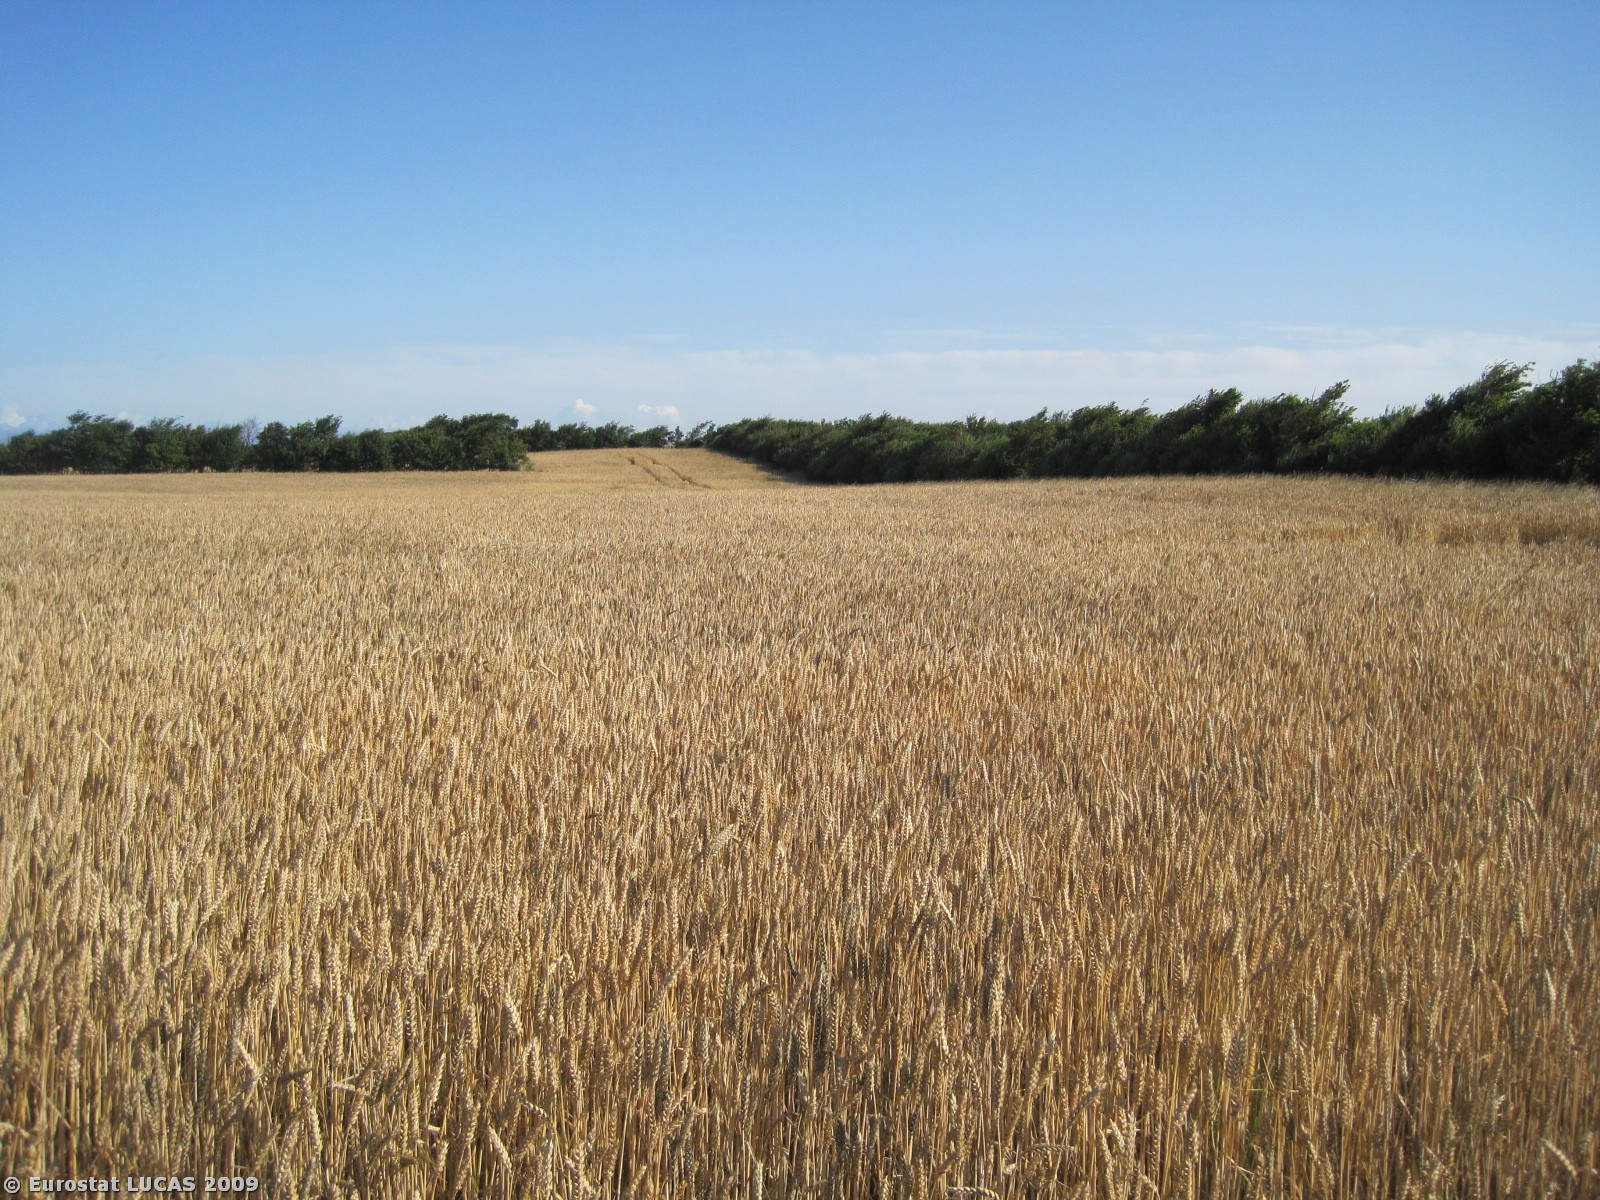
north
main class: Cropland
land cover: Common wheat
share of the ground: > 75 %
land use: Agriculture (excluding fallow land and kitchen gardens)
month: July
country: DK
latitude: 56.7341
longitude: 8.3185
